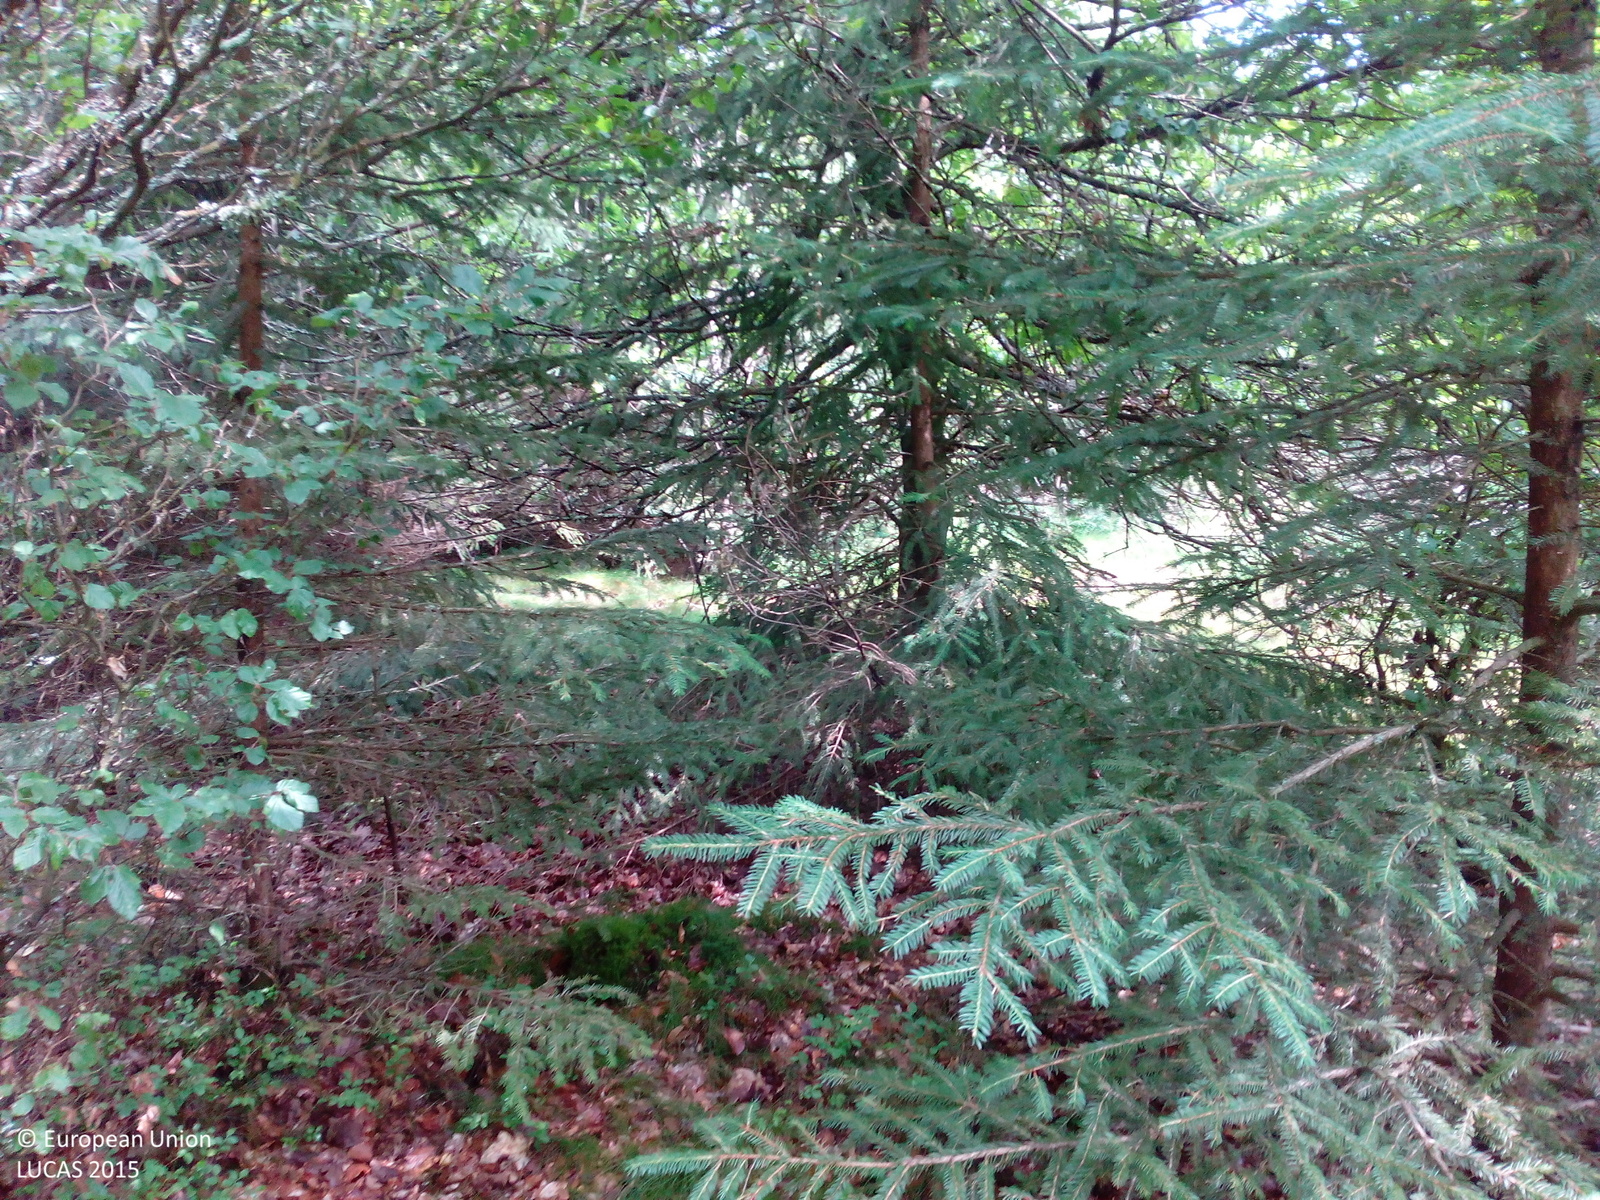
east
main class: Woodland
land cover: Spruce dominated mixed woodland
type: hemiboreal forest and nemoral coniferous forest and mixed broadleaved-coniferous forest
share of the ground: > 75 %
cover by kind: coniferous forest trees 60 %, broadleaved forest trees 25 %, herbaceous plants 15 %
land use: Forestry
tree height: < 5 m
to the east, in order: Spruce dominated mixed woodland; Spruce dominated coniferous woodland; Grass margins; Tracks; Spruce dominated coniferous woodland; Broadleaved woodland; Spruce dominated coniferous woodland; Grassland without tree/shrub cover
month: July
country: DE
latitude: 49.7098
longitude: 12.3709
